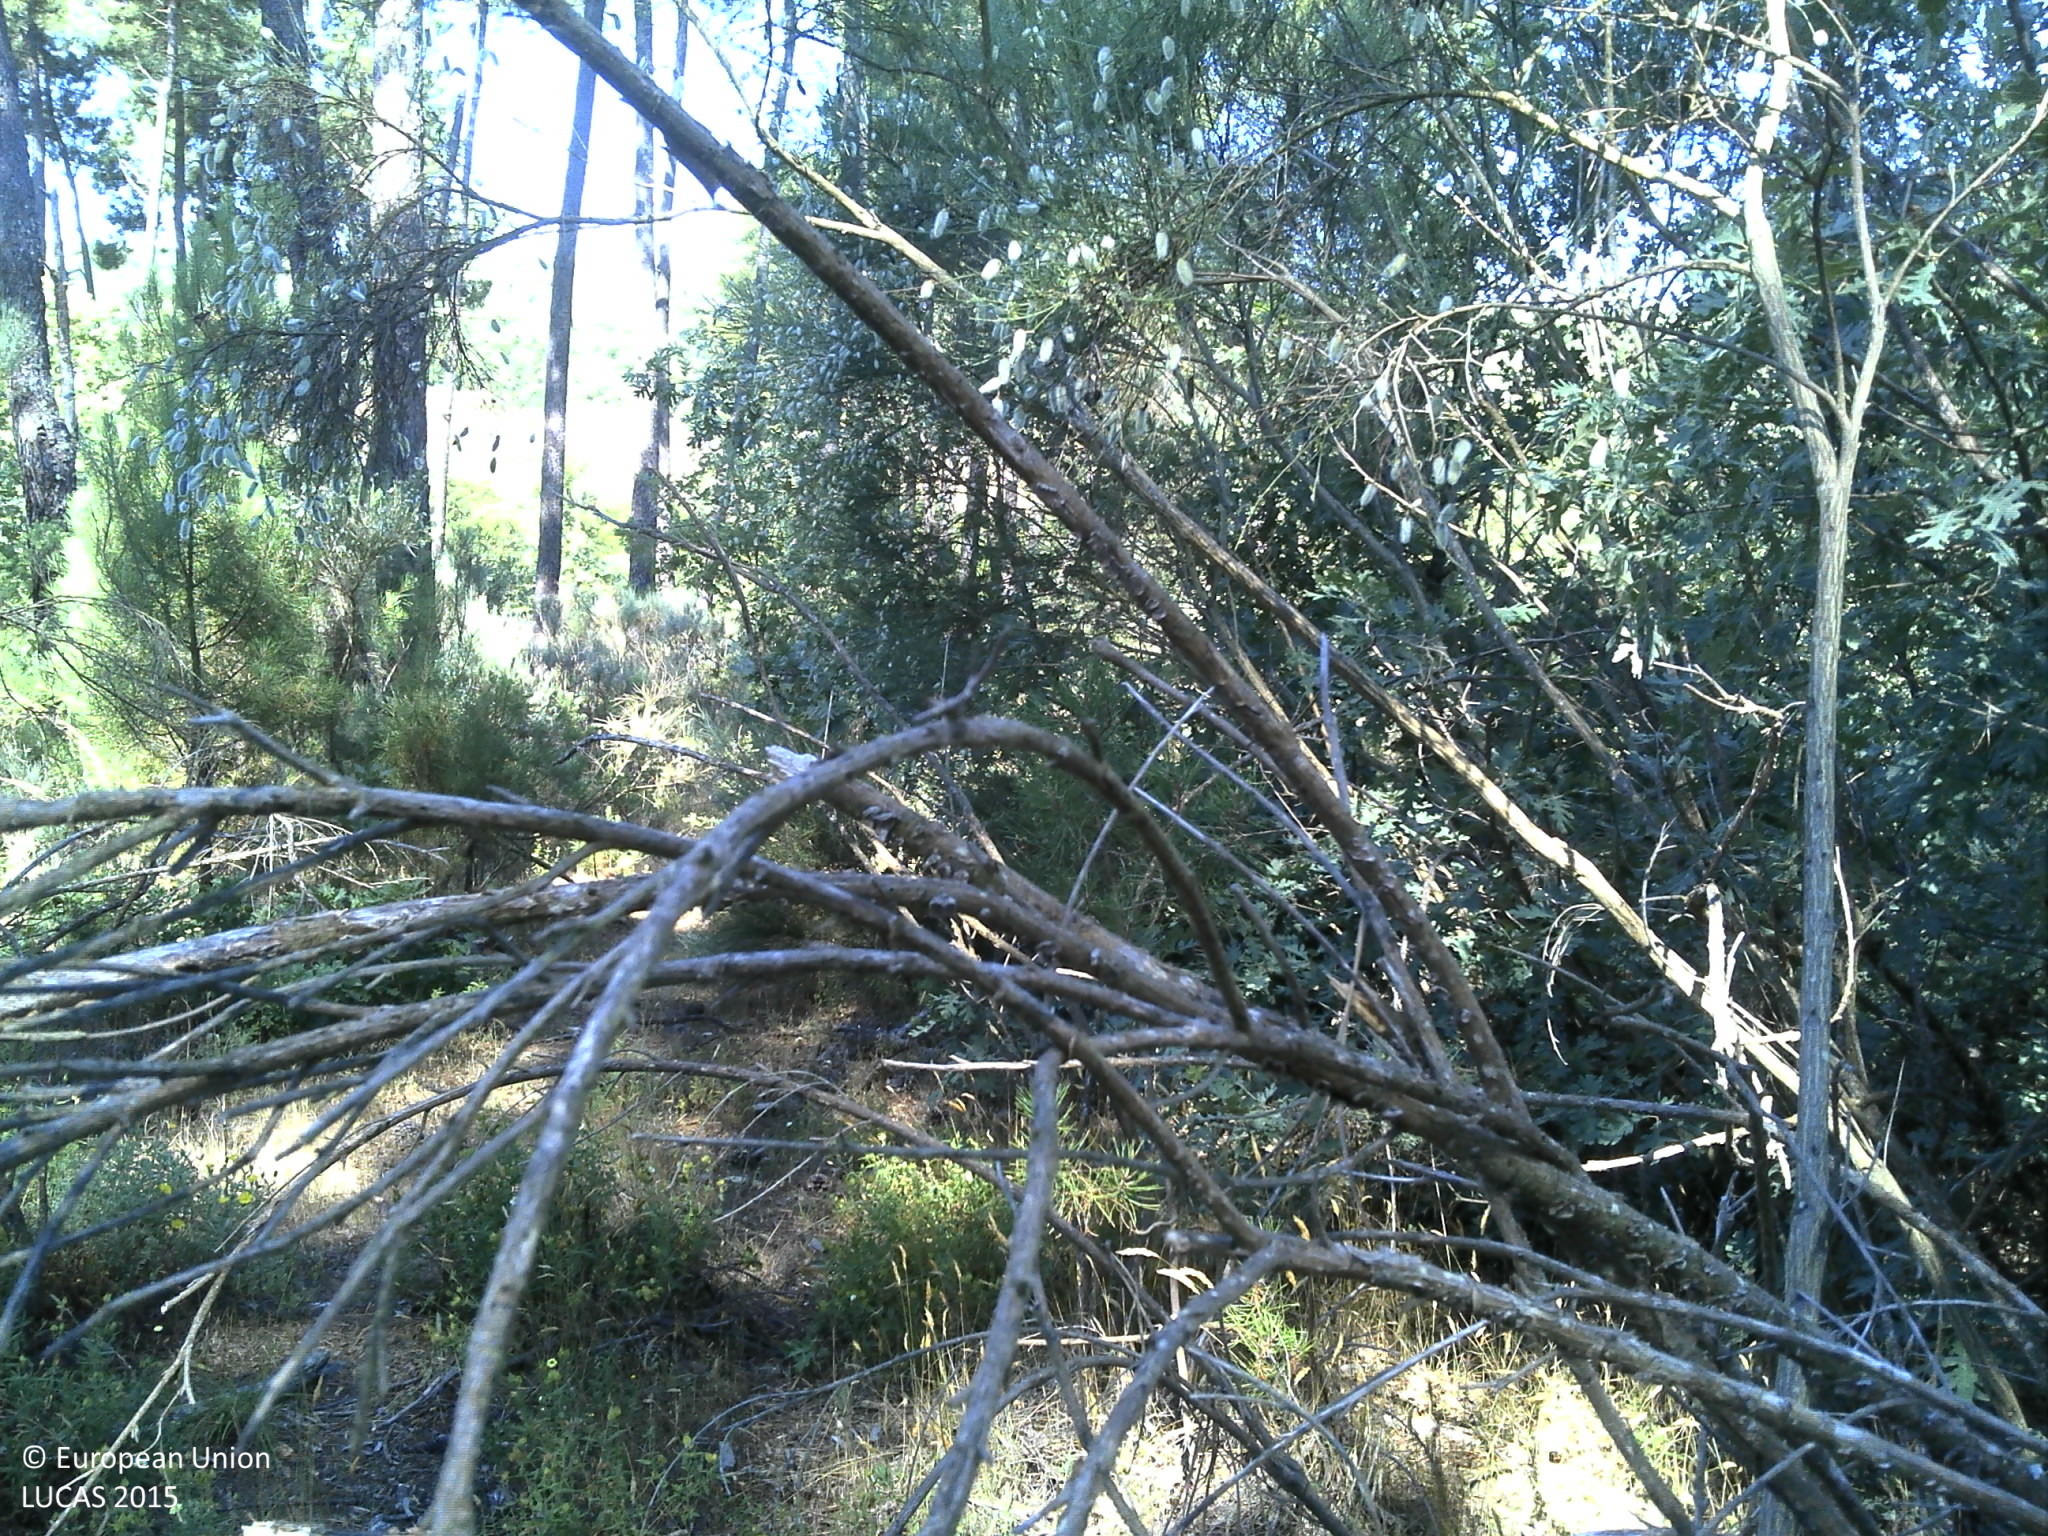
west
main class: Woodland
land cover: Pine dominated mixed woodland
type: coniferous forest of the mediterranean region
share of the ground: 50 - 75 %
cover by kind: shrubs 50 %, coniferous forest trees 30 %, broadleaved forest trees 10 %, unconsolidated bare surface 10 %
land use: Forestry
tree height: > 5 m
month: June
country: PT
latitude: 40.7597
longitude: -7.2253
